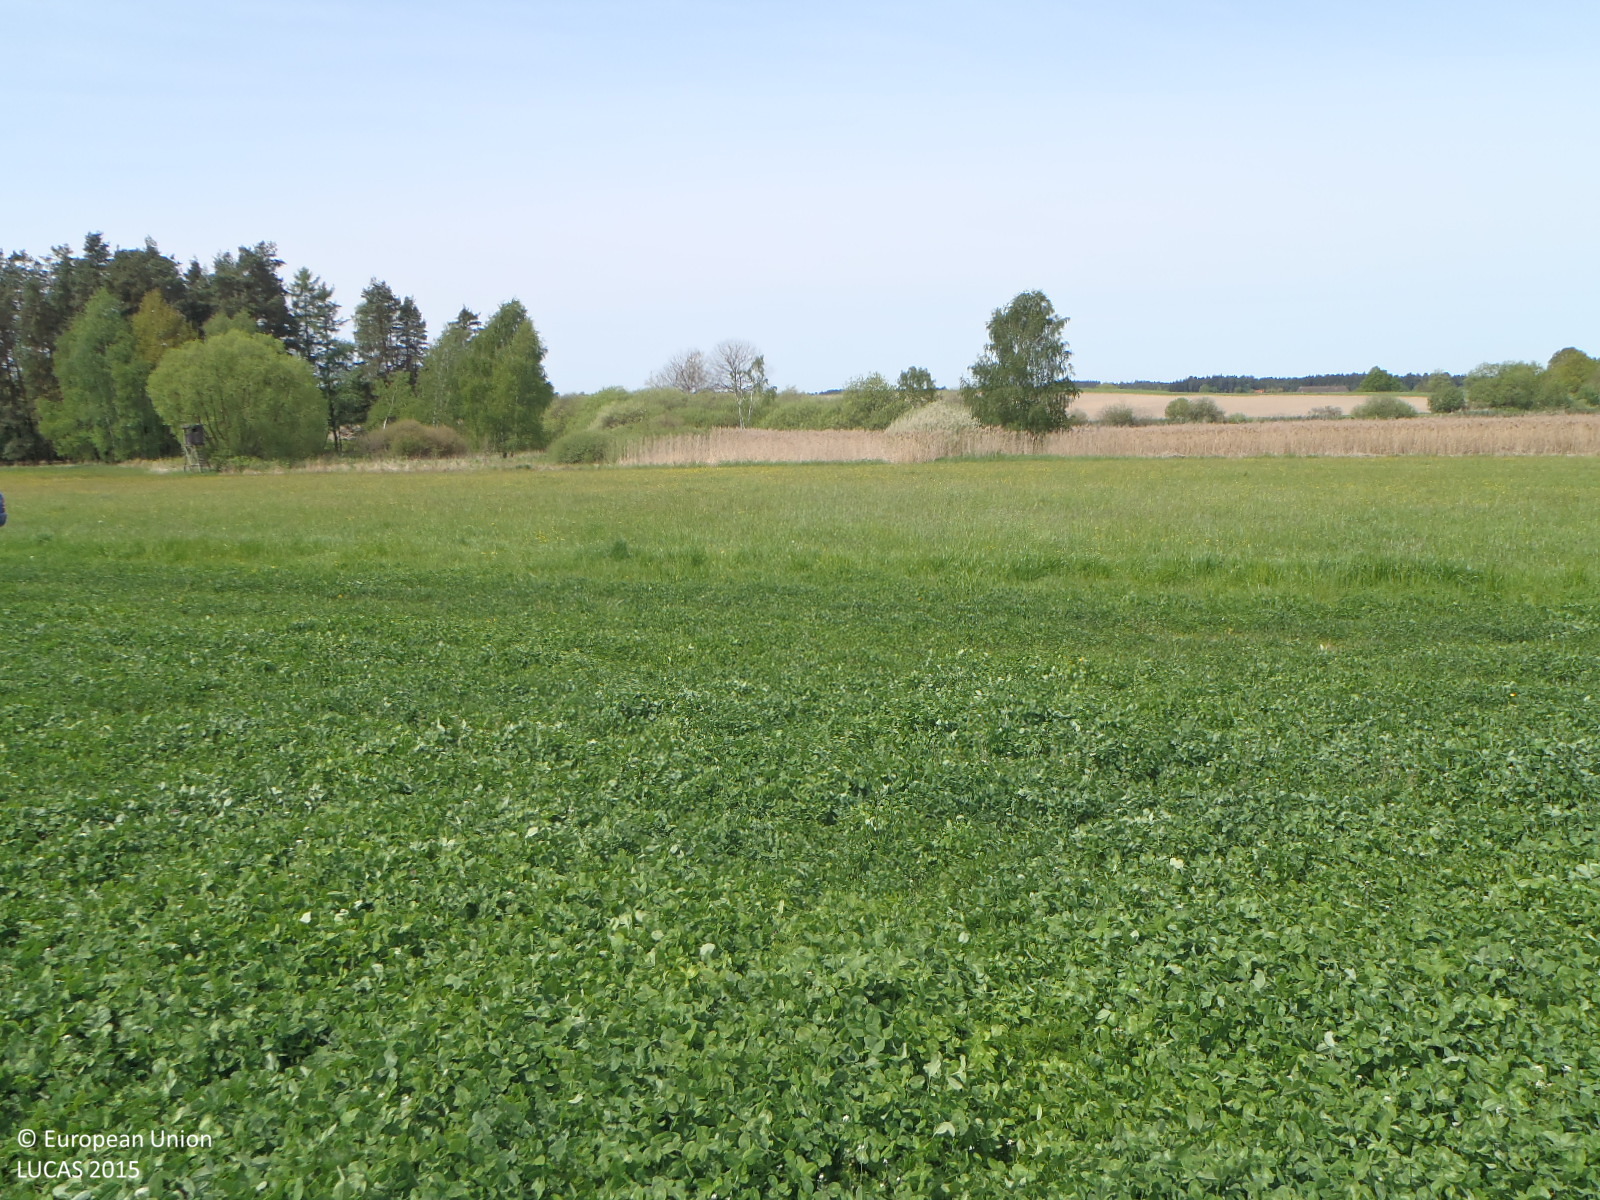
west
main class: Cropland
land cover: Clovers
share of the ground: > 75 %
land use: Agriculture (excluding fallow land and kitchen gardens)
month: May
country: CZ
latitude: 49.1601
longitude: 14.8976
